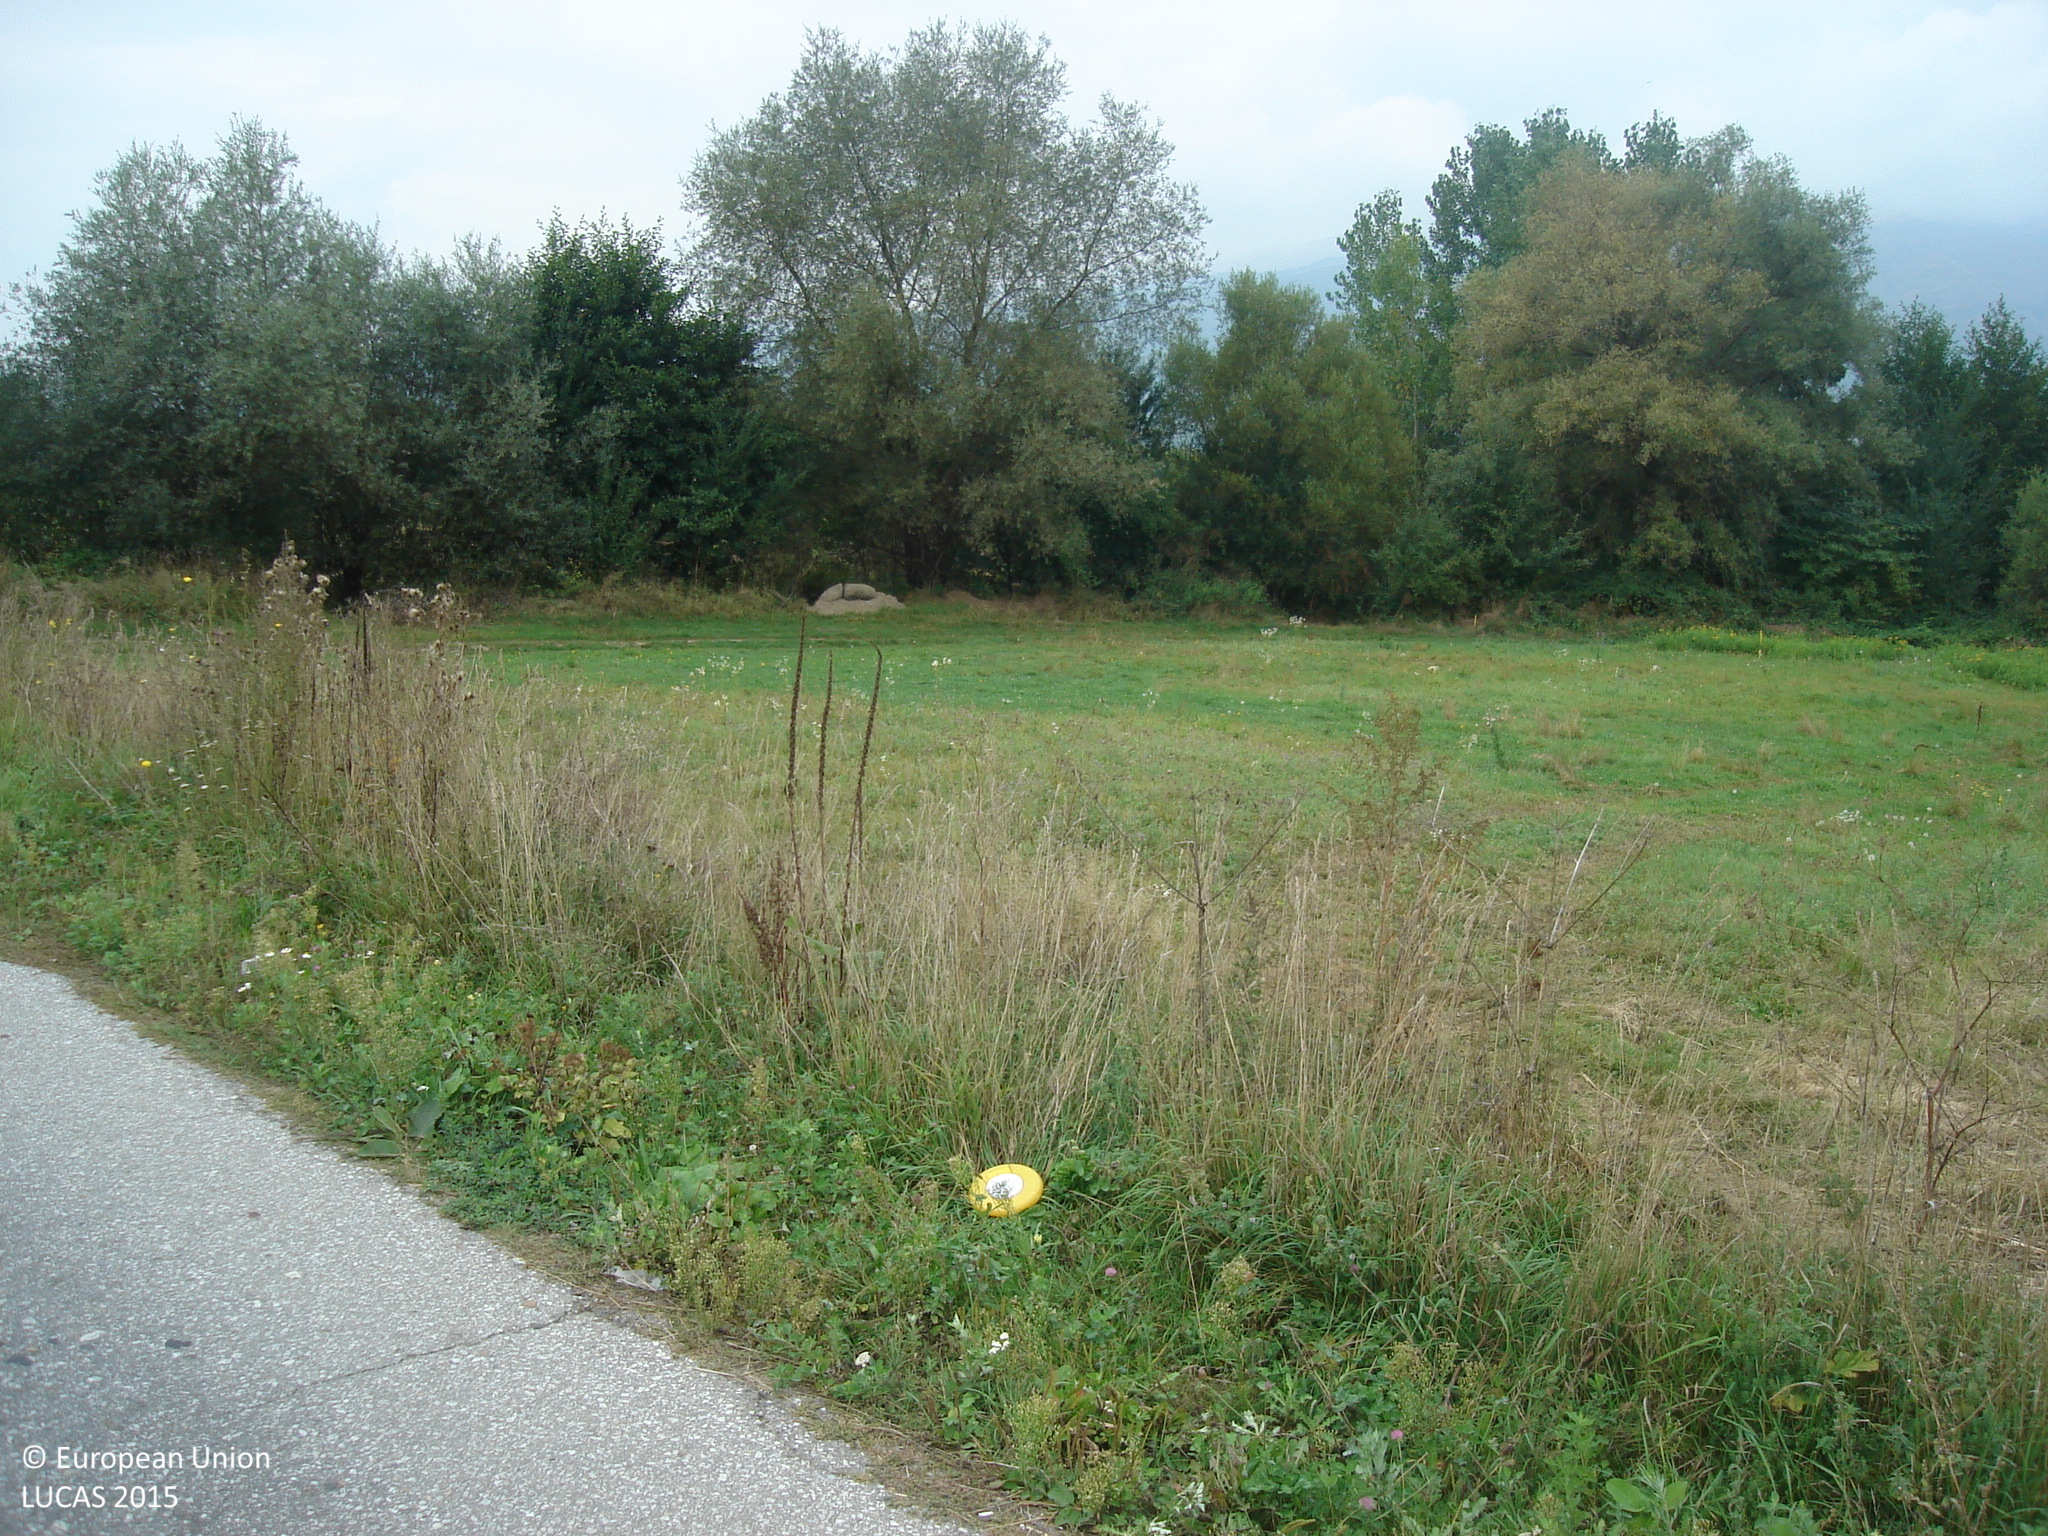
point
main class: Grassland
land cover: Grassland without tree/shrub cover
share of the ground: > 75 %
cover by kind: herbaceous plants 100 %
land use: Road transport
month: September
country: BG
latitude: 42.7063
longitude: 24.2229
